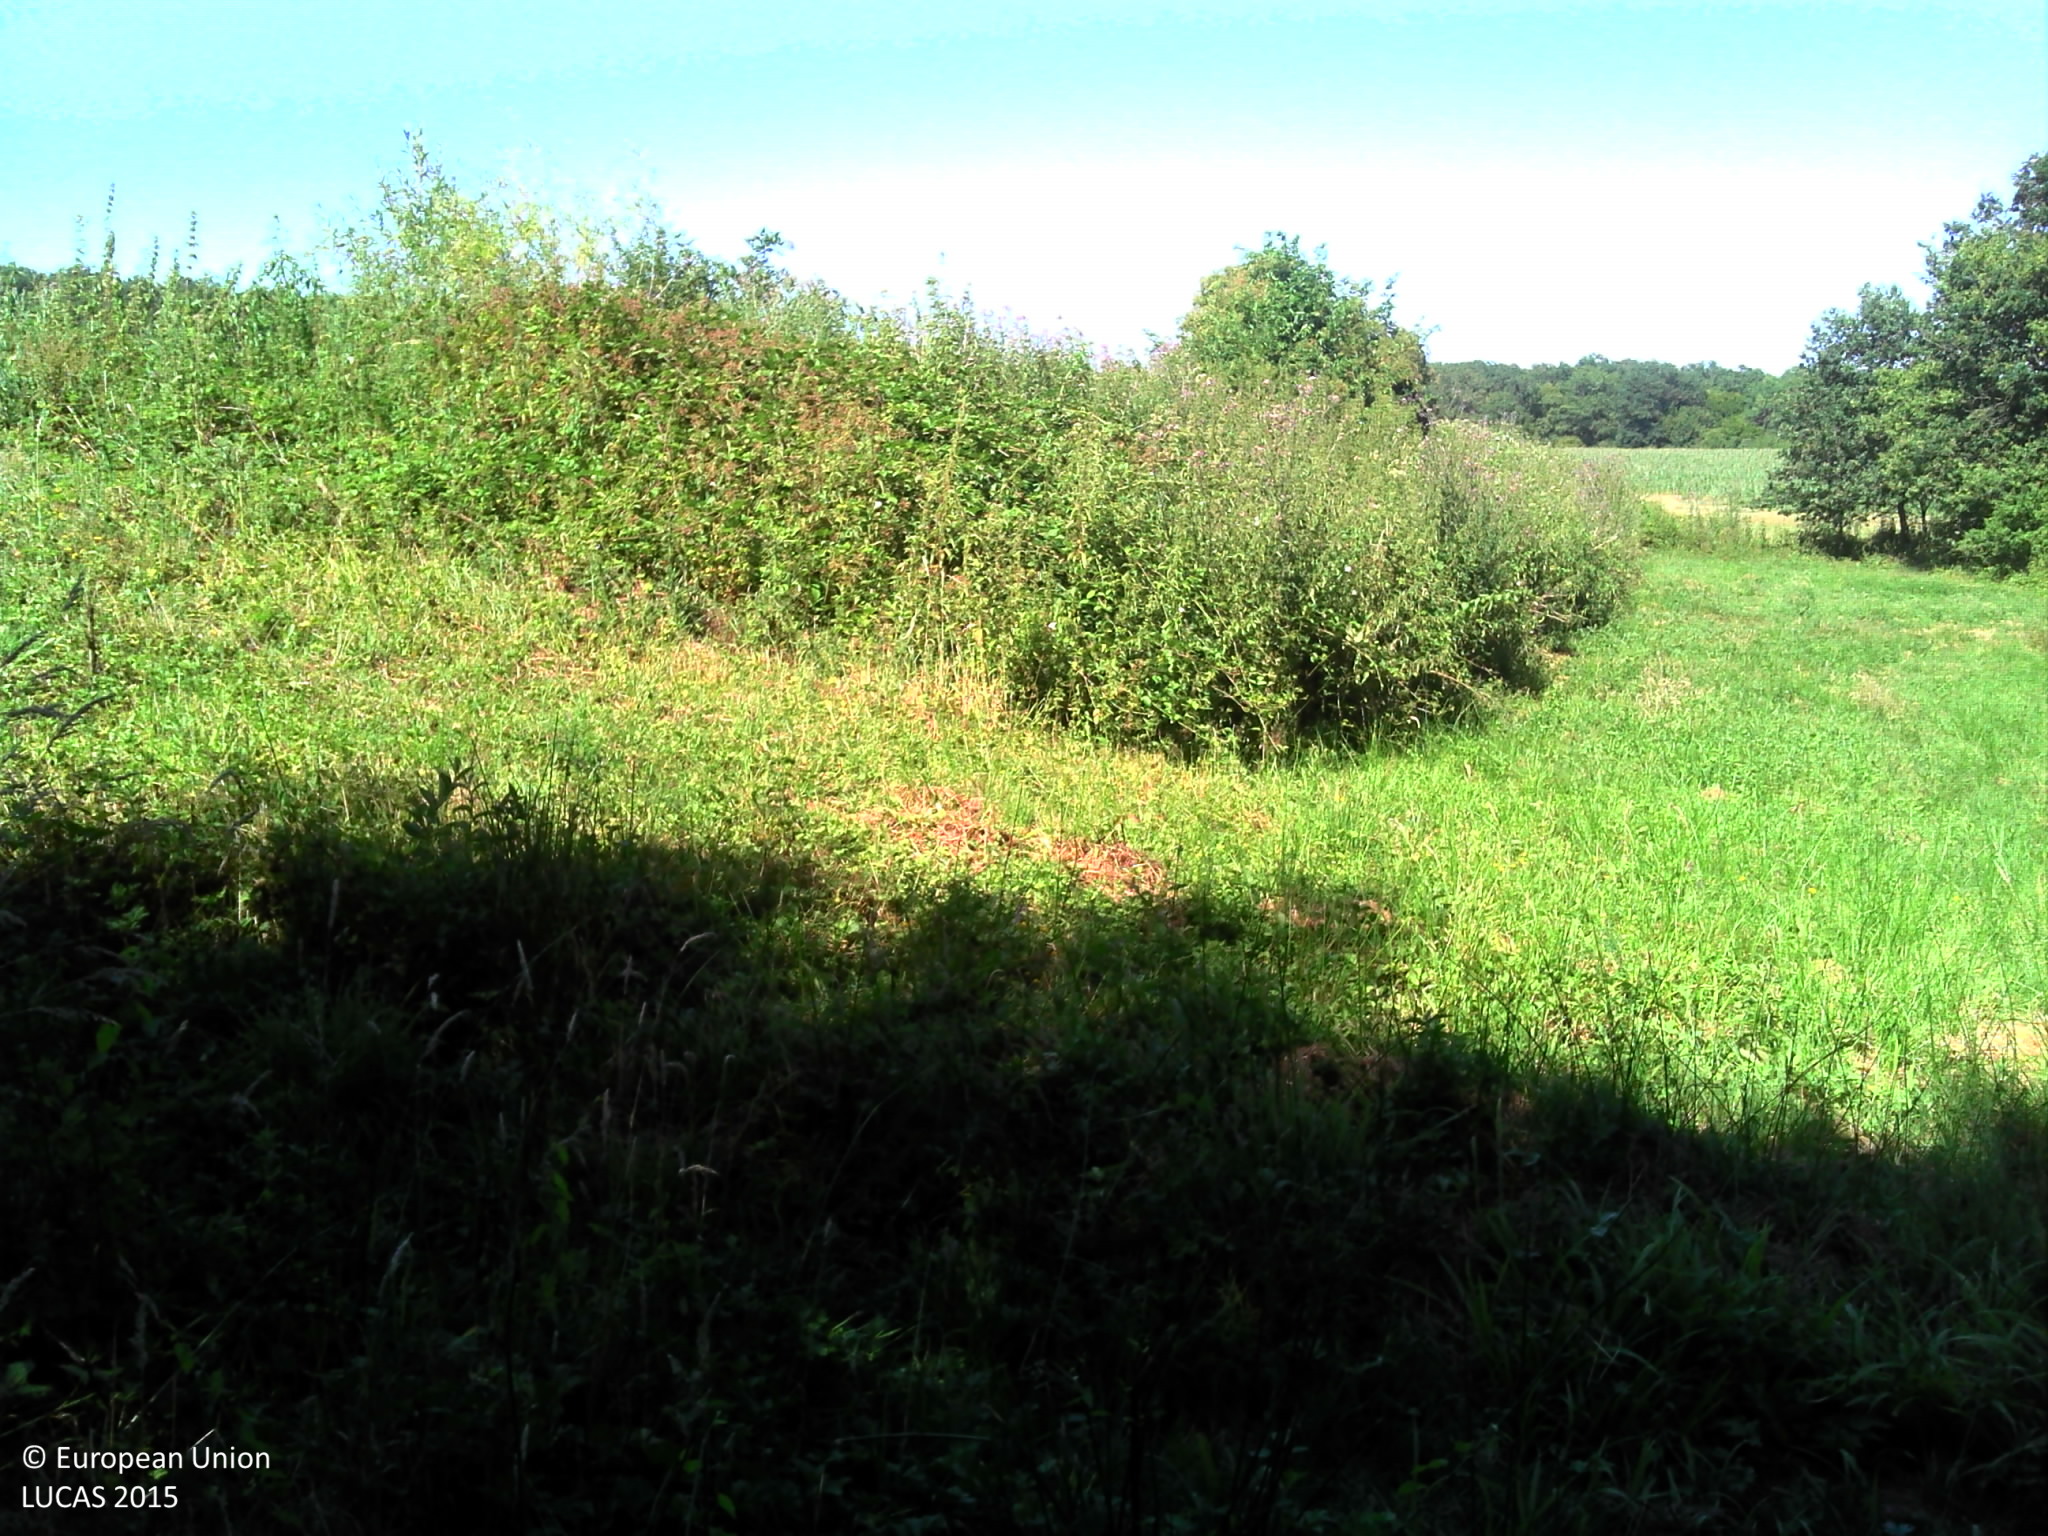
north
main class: Grassland
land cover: Grassland without tree/shrub cover
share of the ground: > 75 %
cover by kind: herbaceous plants 100 %
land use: Agriculture (excluding fallow land and kitchen gardens)
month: July
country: FR
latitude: 46.9511
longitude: 3.5464
